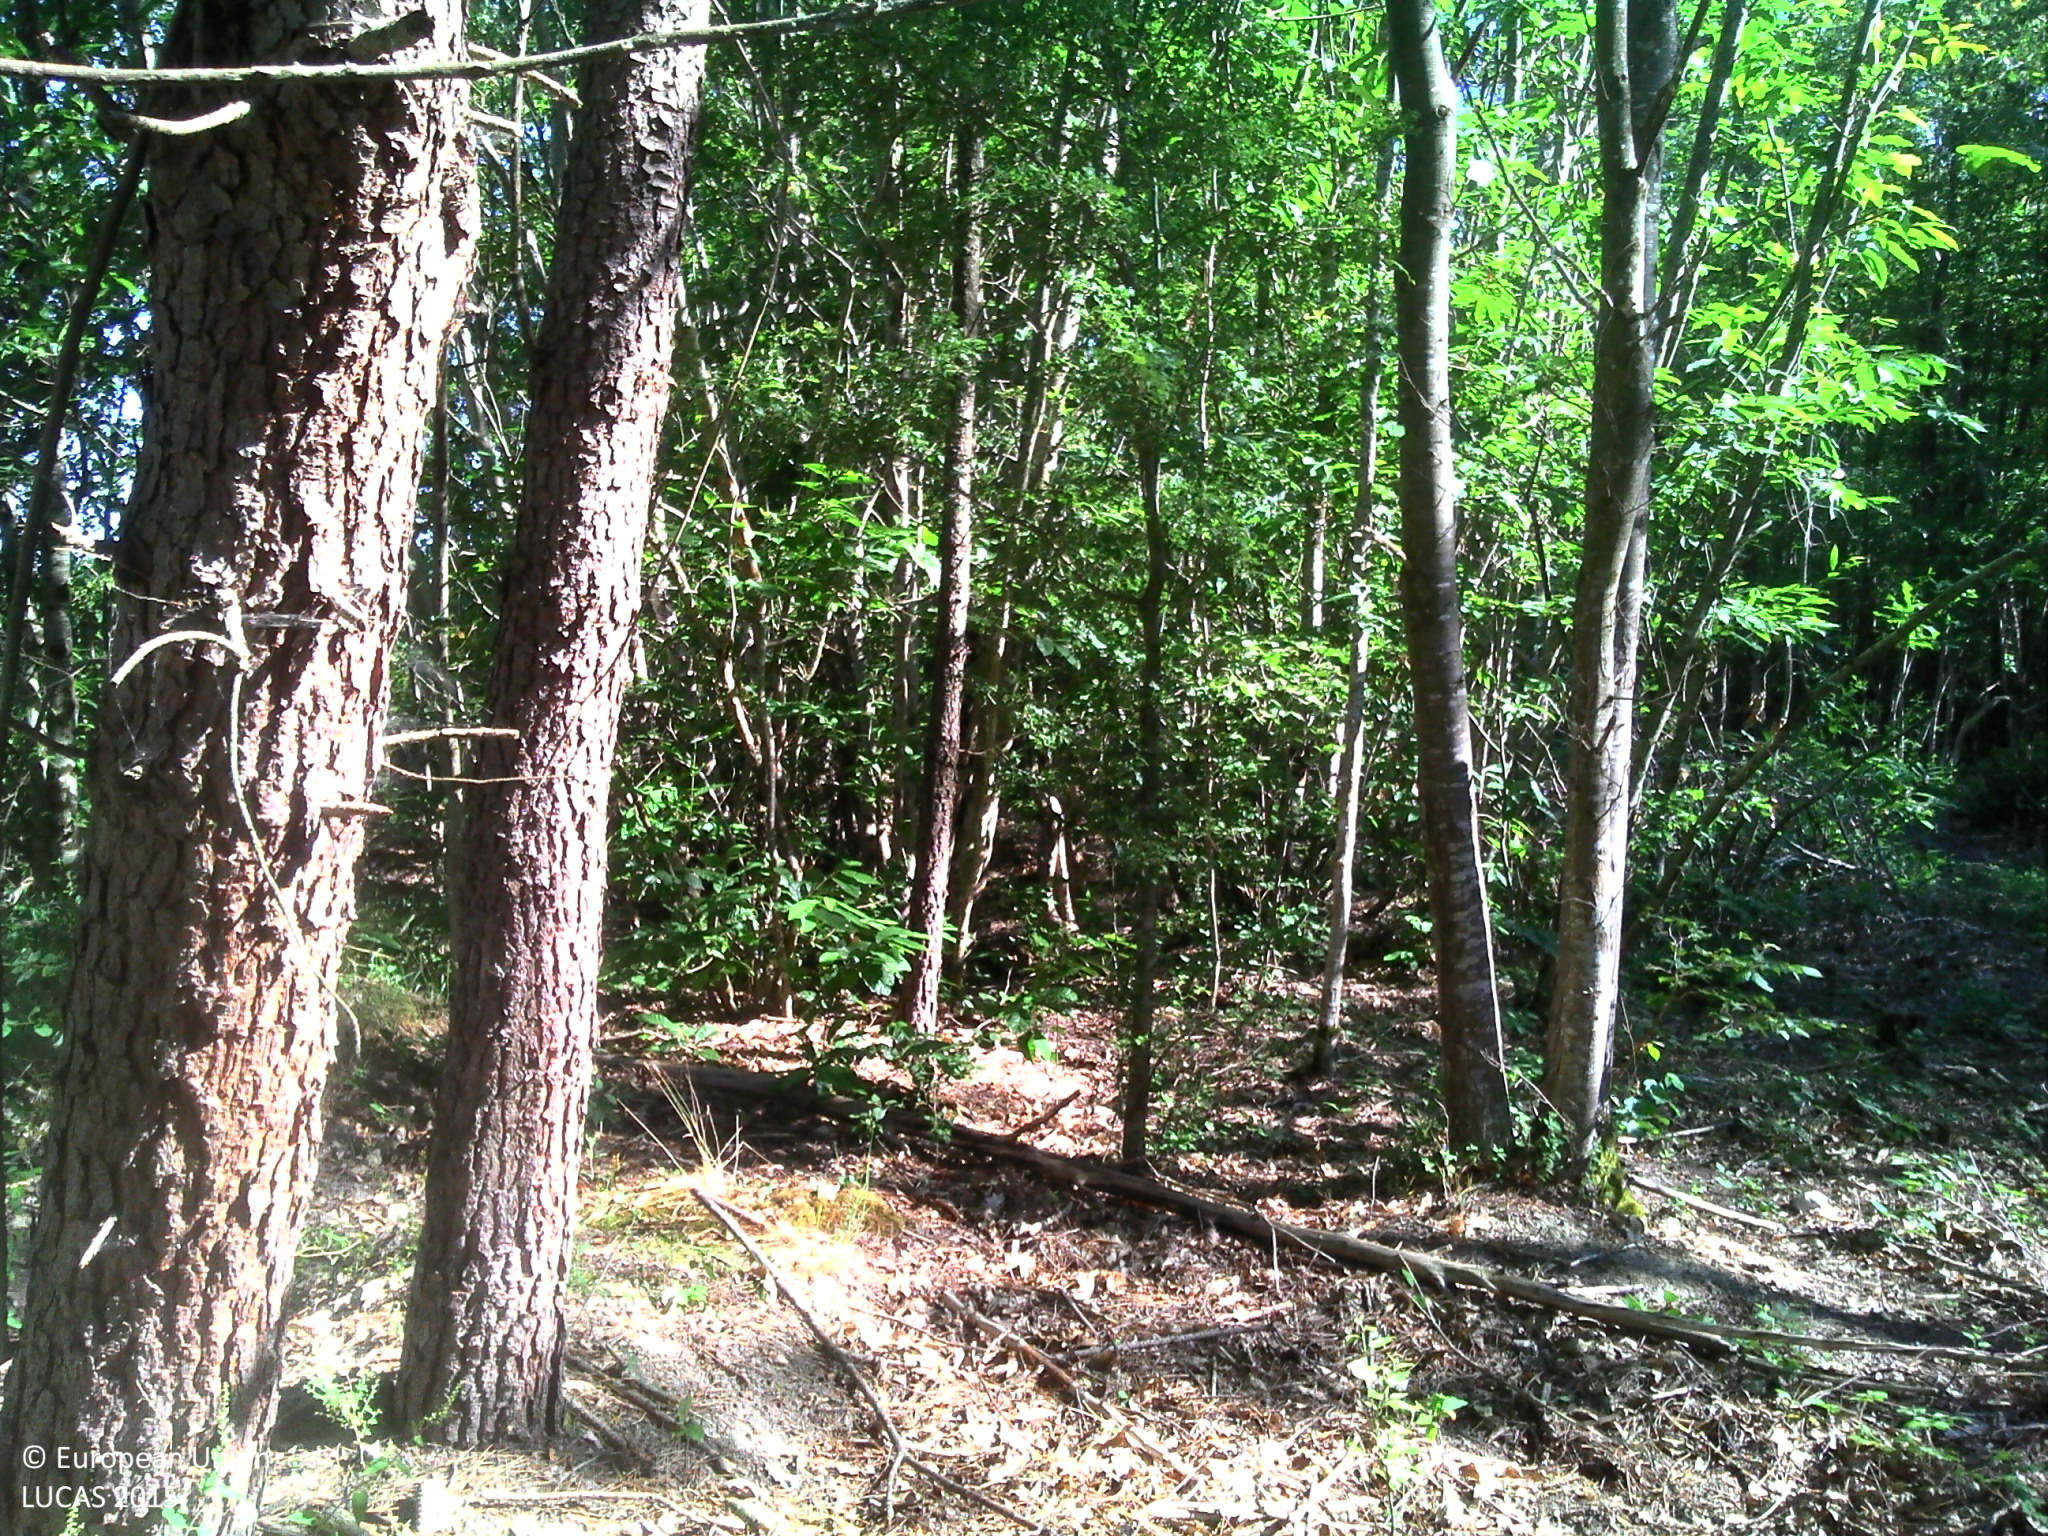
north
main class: Woodland
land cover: Broadleaved woodland
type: mesophytic deciduous forest
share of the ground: > 75 %
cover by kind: broadleaved forest trees 75 %, shrubs 10 %, coniferous forest trees 5 %, herbaceous plants 5 %, lichens and mosses 5 %
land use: Forestry
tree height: > 5 m
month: June
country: FR
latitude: 47.4001
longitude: 0.3447
